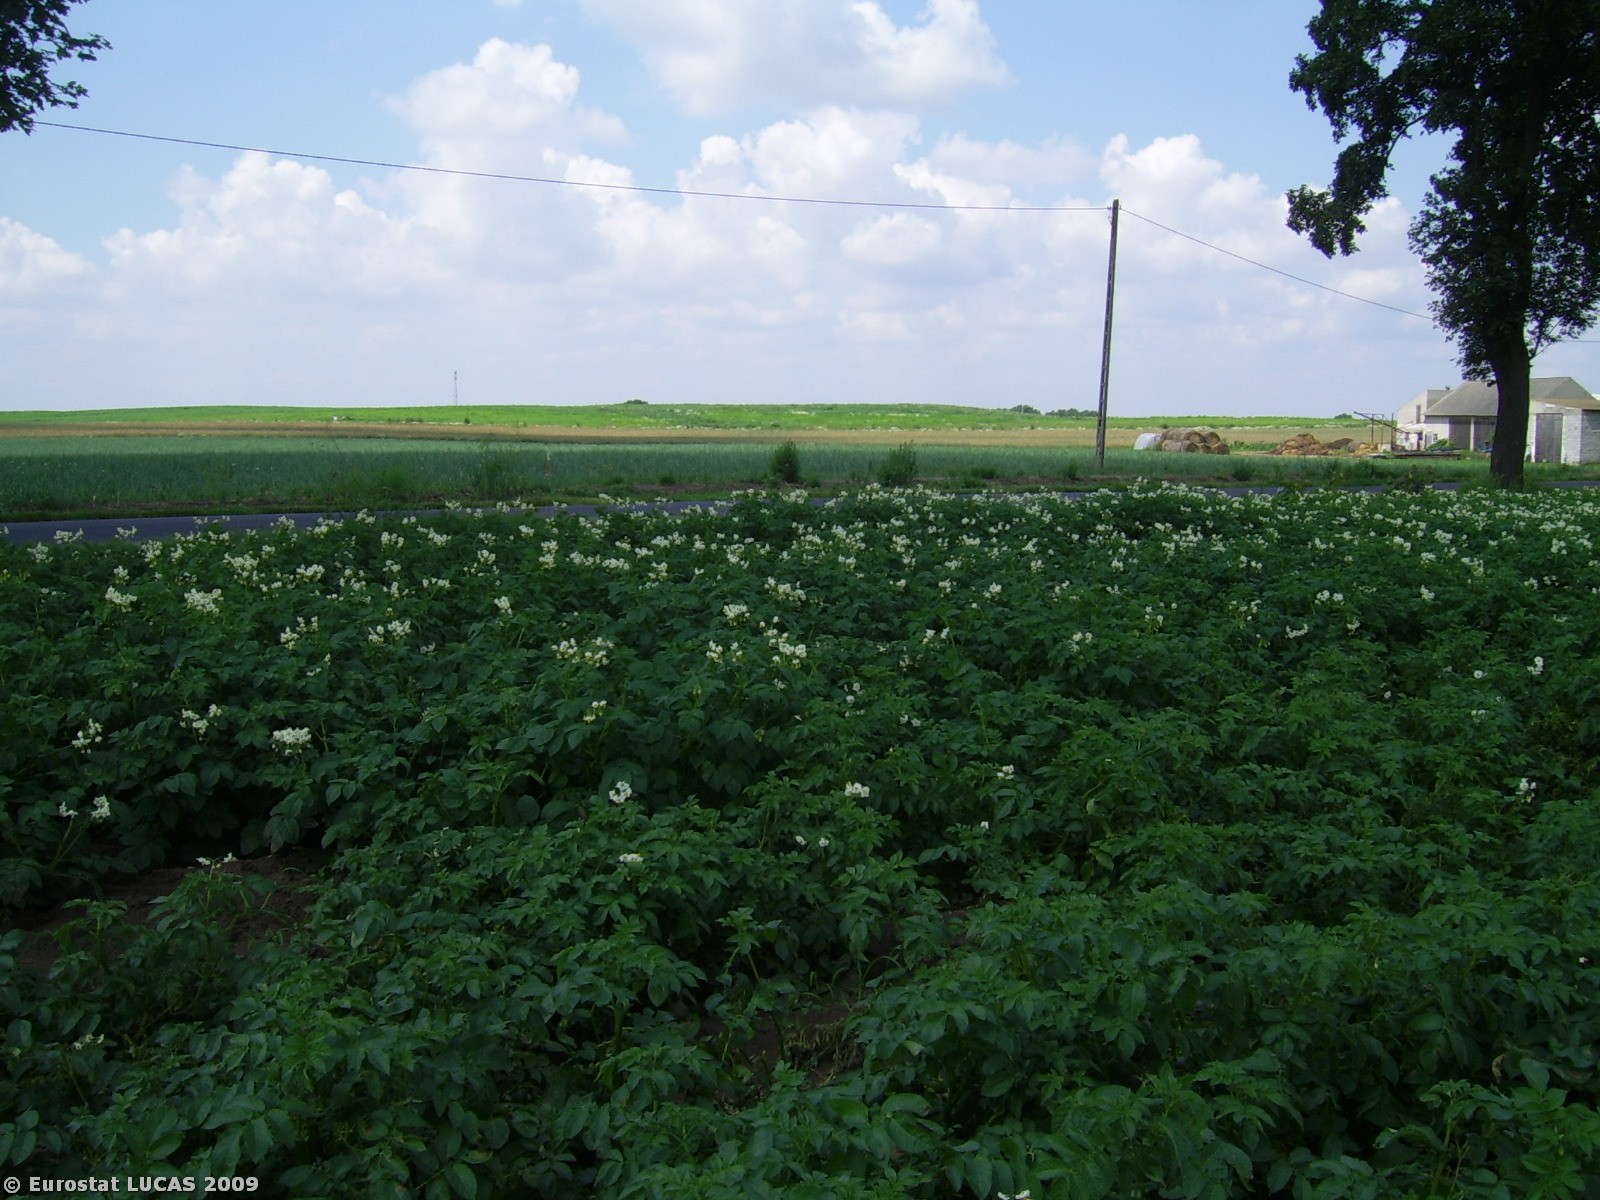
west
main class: Cropland
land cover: Potatoes
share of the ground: > 75 %
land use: Agriculture (excluding fallow land and kitchen gardens)
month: July
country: PL
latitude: 52.6583
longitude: 18.1328
